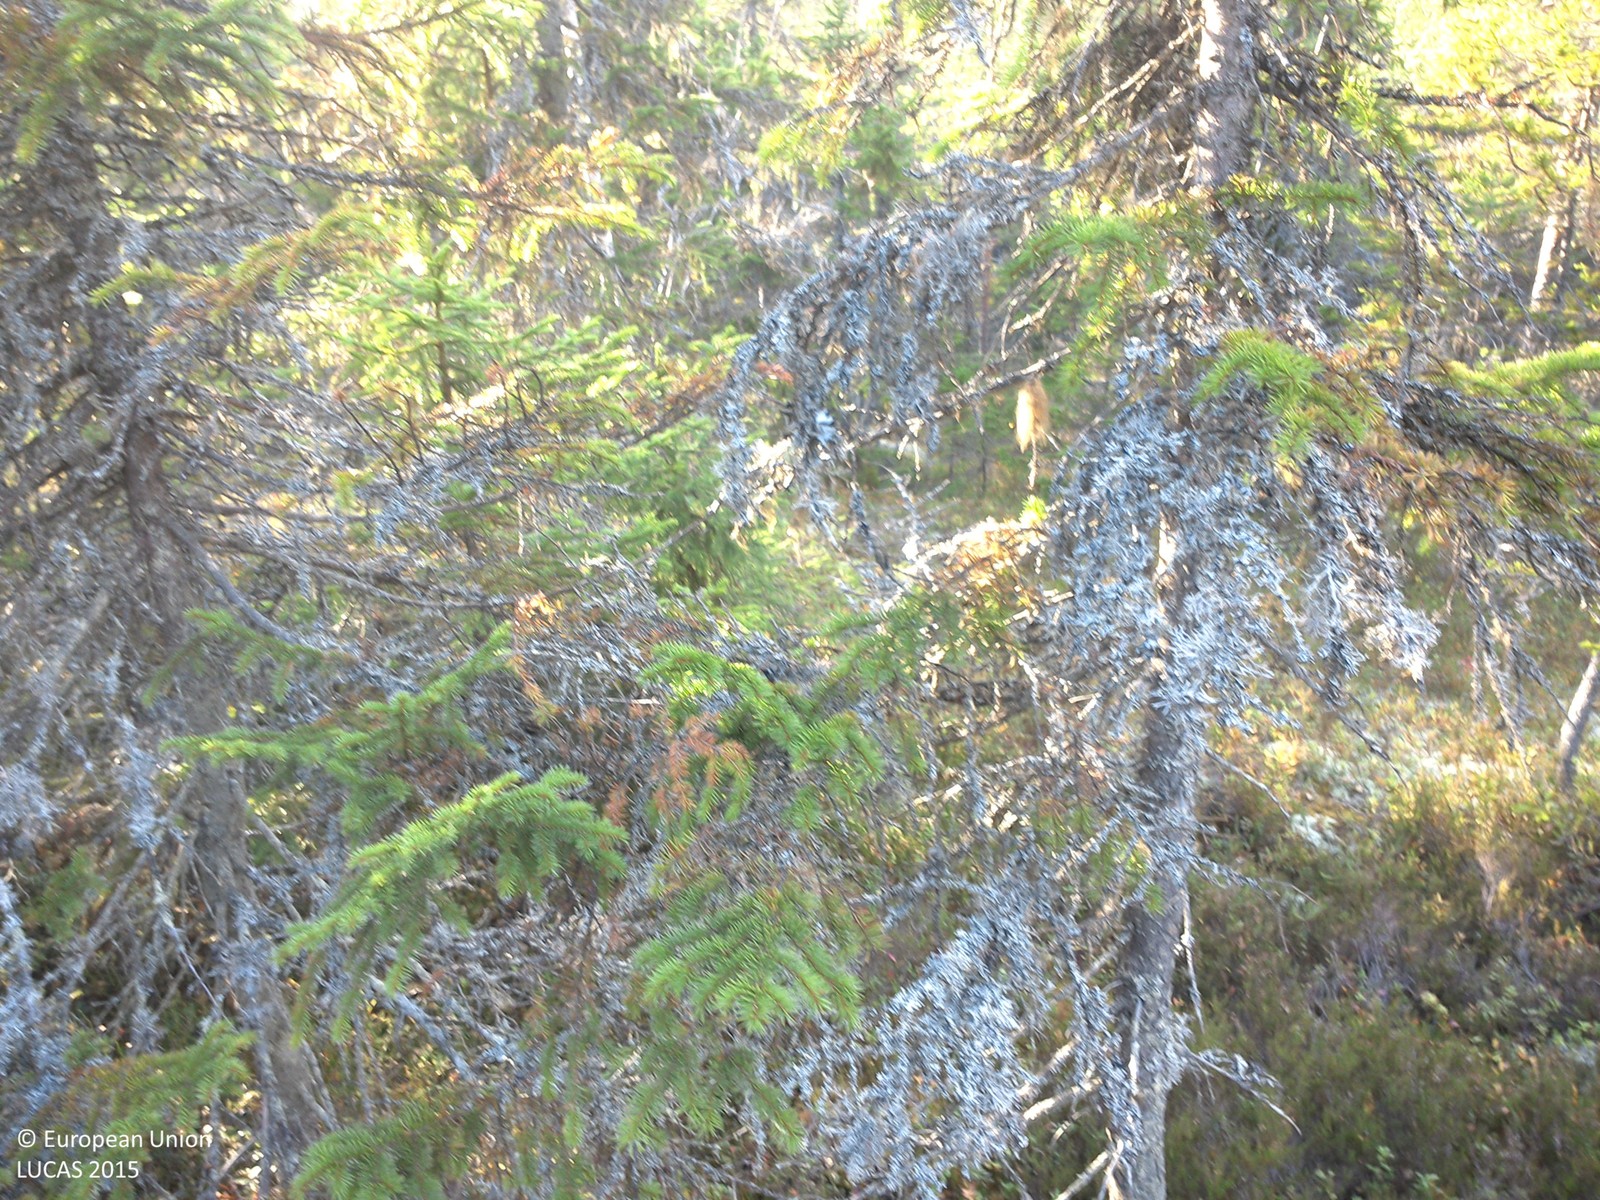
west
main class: Woodland
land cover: Other coniferous woodland
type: boreal forest
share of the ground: 50 - 75 %
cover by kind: coniferous forest trees 50 %, shrubs 50 %
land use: Forestry
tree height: > 5 m
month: October
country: SE
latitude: 63.8829
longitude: 19.9766
